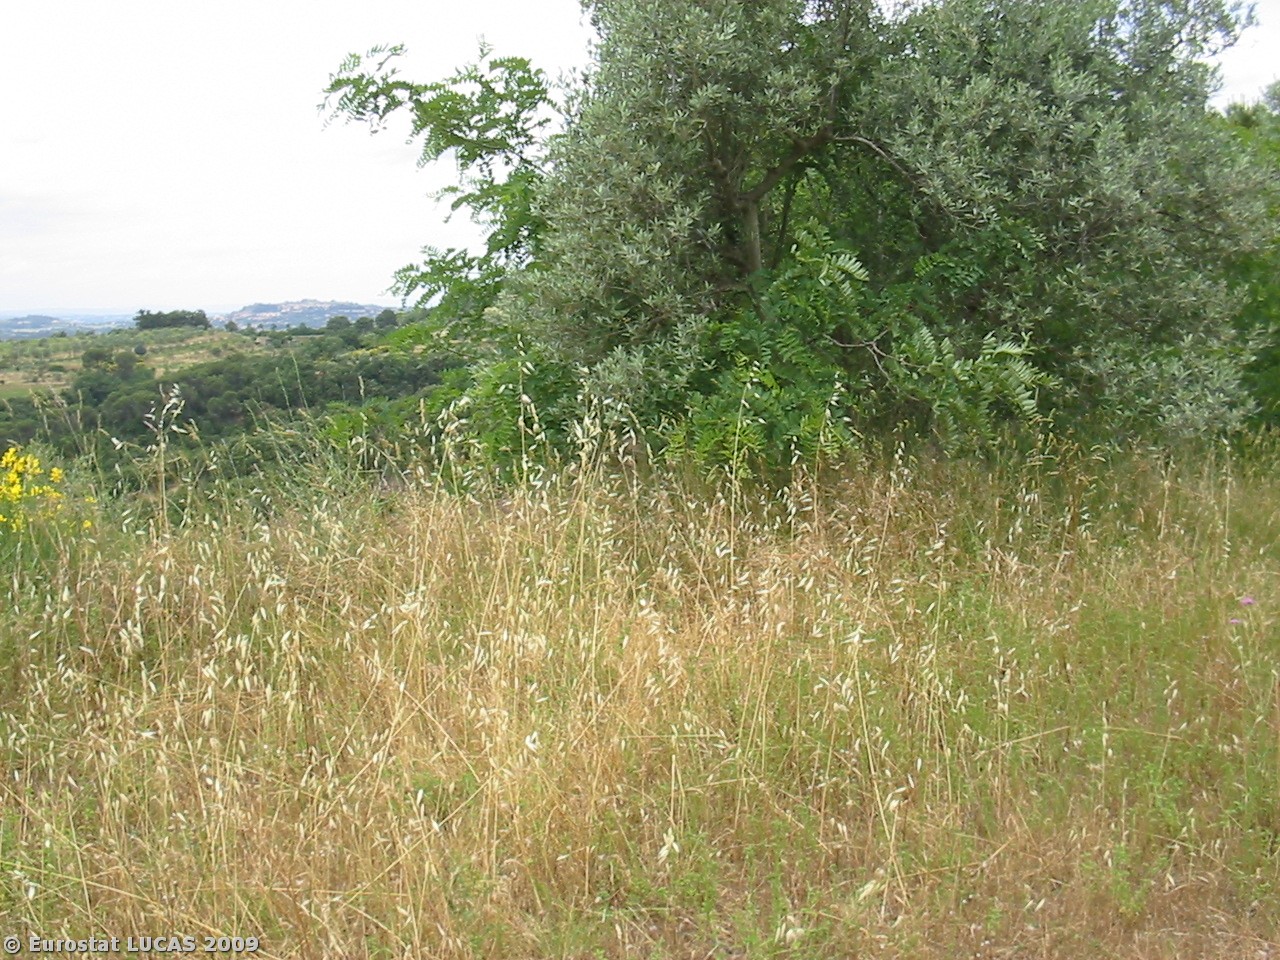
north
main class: Cropland
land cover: Olive groves
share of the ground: 25 - 50 %
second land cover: Spontaneously vegetated surfaces
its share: > 75 %
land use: Agriculture (excluding fallow land and kitchen gardens)
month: June
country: IT
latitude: 42.9596
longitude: 11.9921
